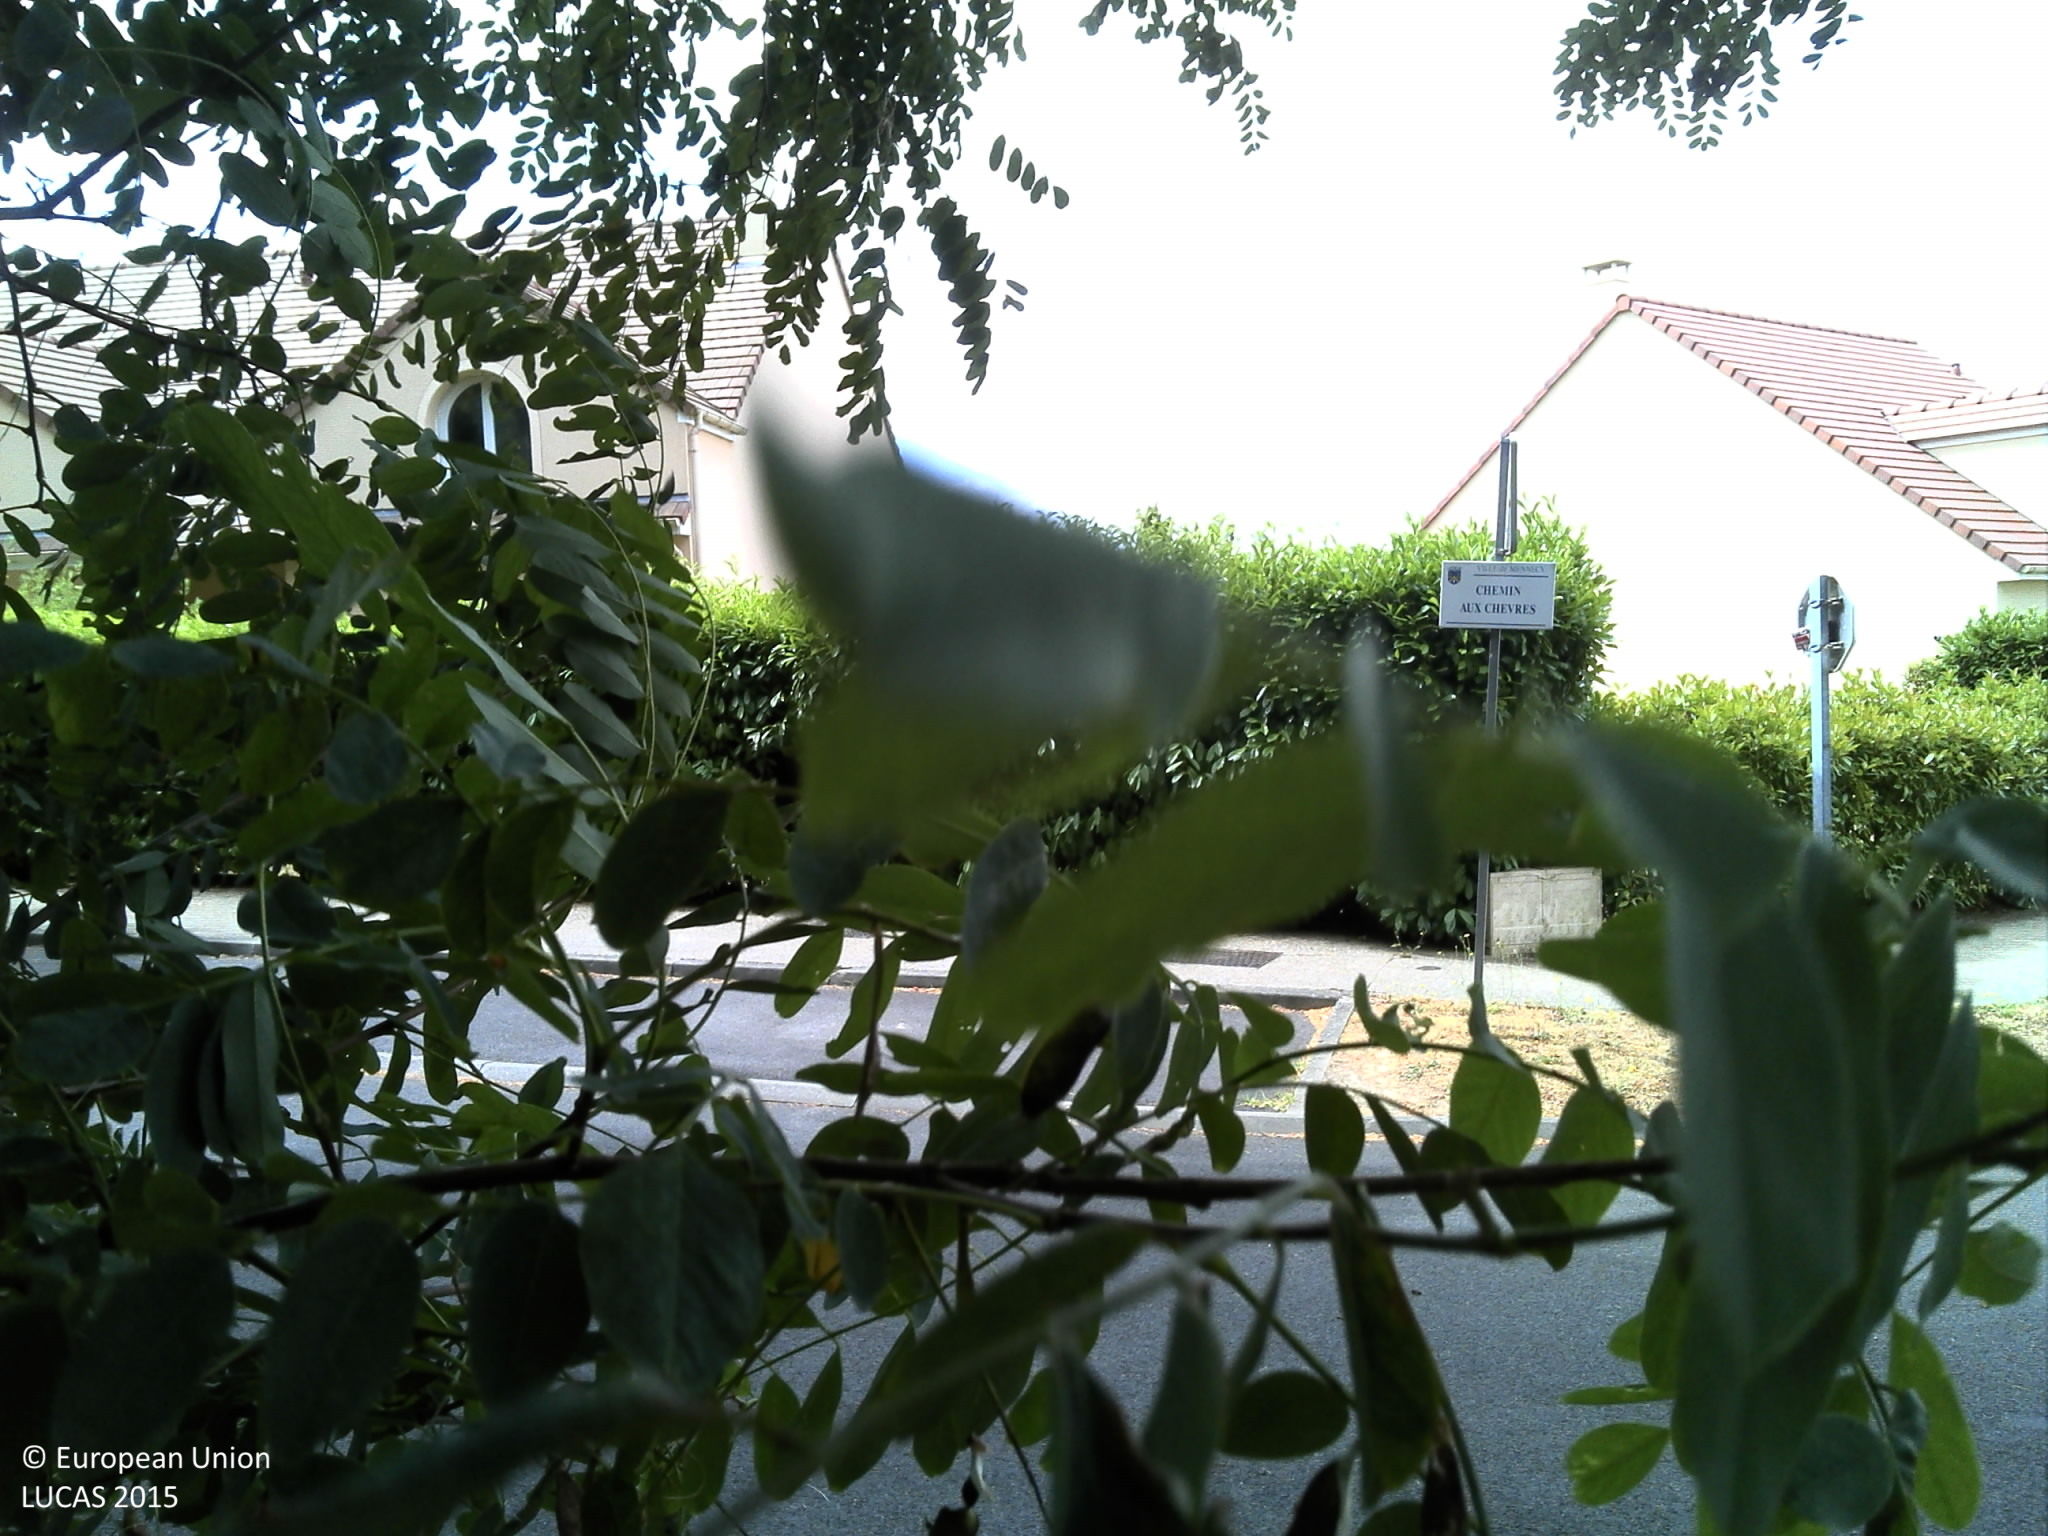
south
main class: Woodland
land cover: Broadleaved woodland
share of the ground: 25 - 50 %
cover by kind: broadleaved forest trees 80 %, herbaceous plants 20 %
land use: Agriculture (excluding fallow land and kitchen gardens)
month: July
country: FR
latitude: 48.5602
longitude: 2.4417
